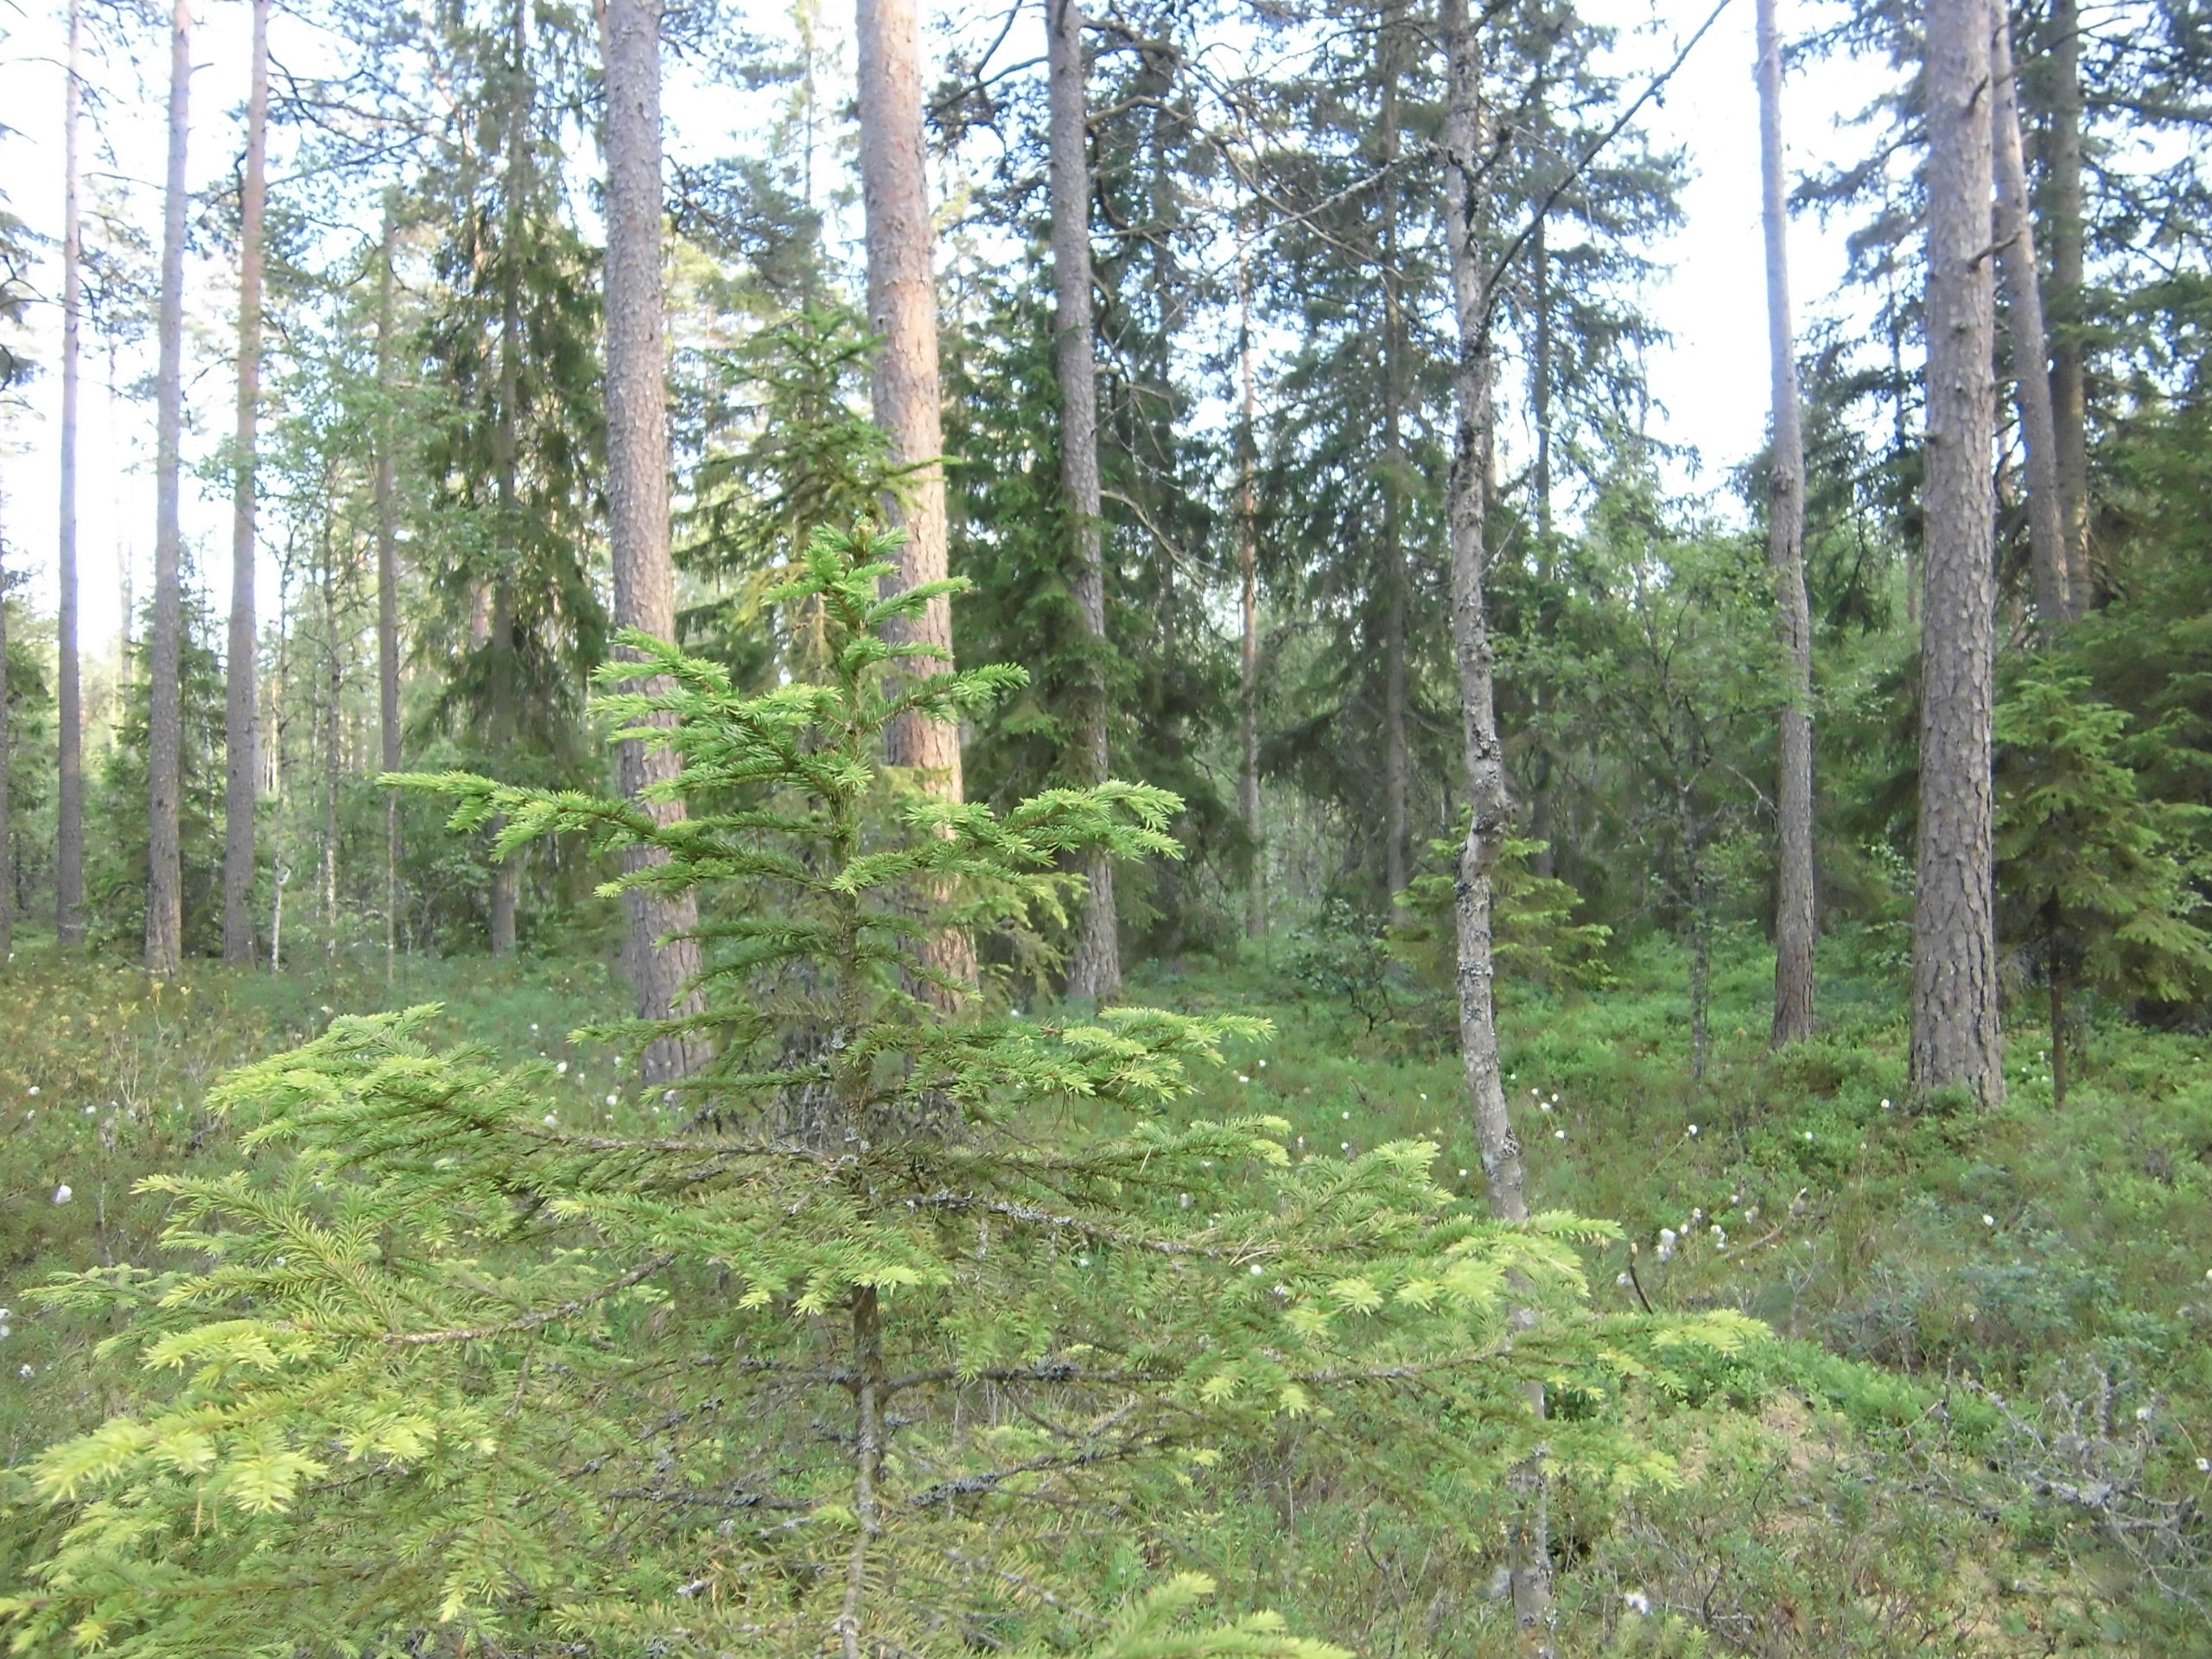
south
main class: Woodland
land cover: Pine dominated coniferous woodland
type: boreal forest
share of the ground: 50 - 75 %
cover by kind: coniferous forest trees 50 %, shrubs 30 %, lichens and mosses 10 %, broadleaved forest trees 5 %, herbaceous plants 5 %
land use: Forestry
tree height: > 5 m
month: July
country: SE
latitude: 57.3052
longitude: 14.7934
